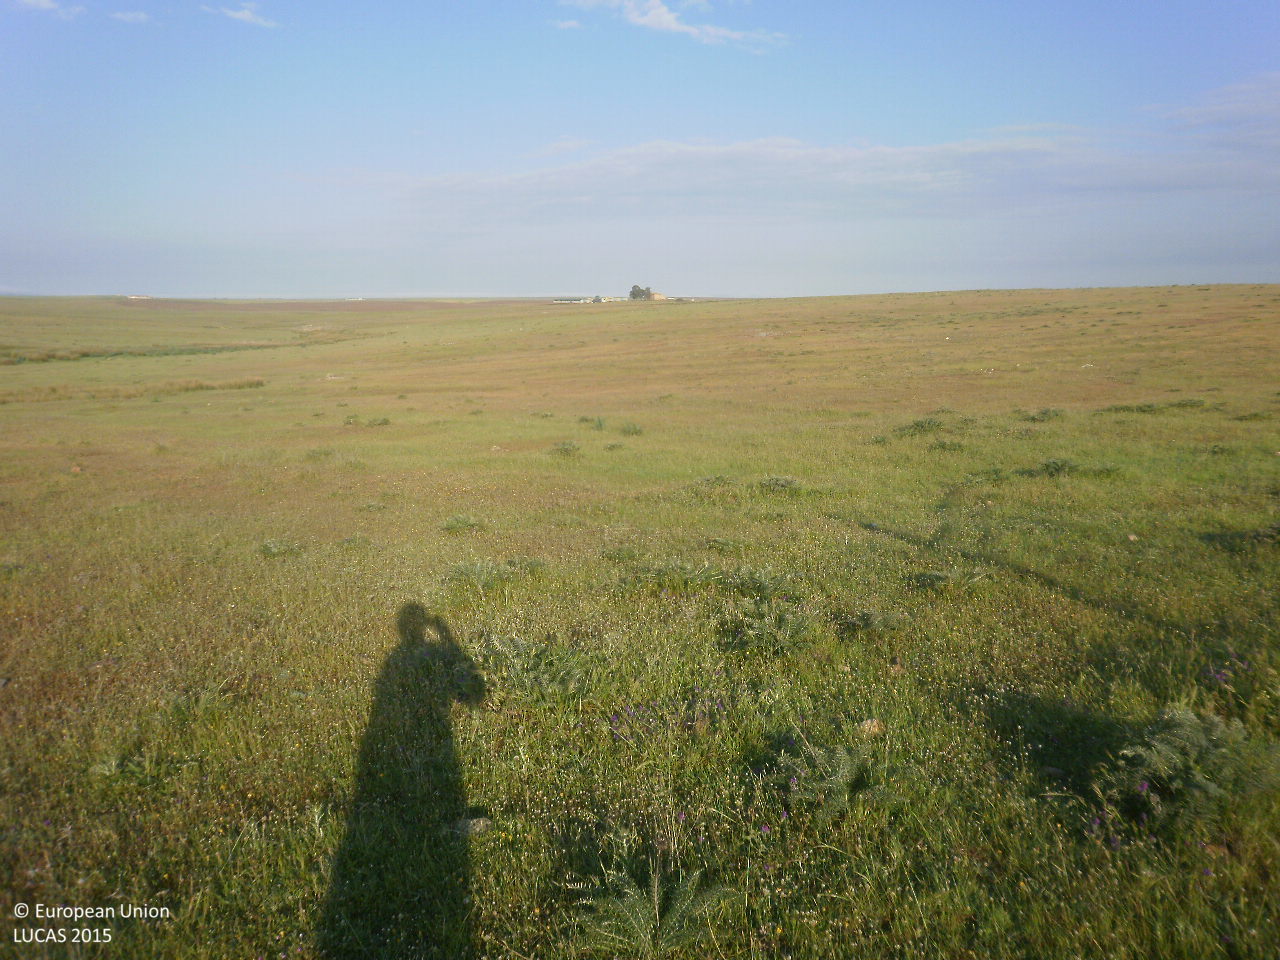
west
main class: Grassland
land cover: Grassland without tree/shrub cover
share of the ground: > 75 %
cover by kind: herbaceous plants 100 %
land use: Agriculture (excluding fallow land and kitchen gardens)
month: April
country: ES
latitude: 38.7782
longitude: -5.2183
